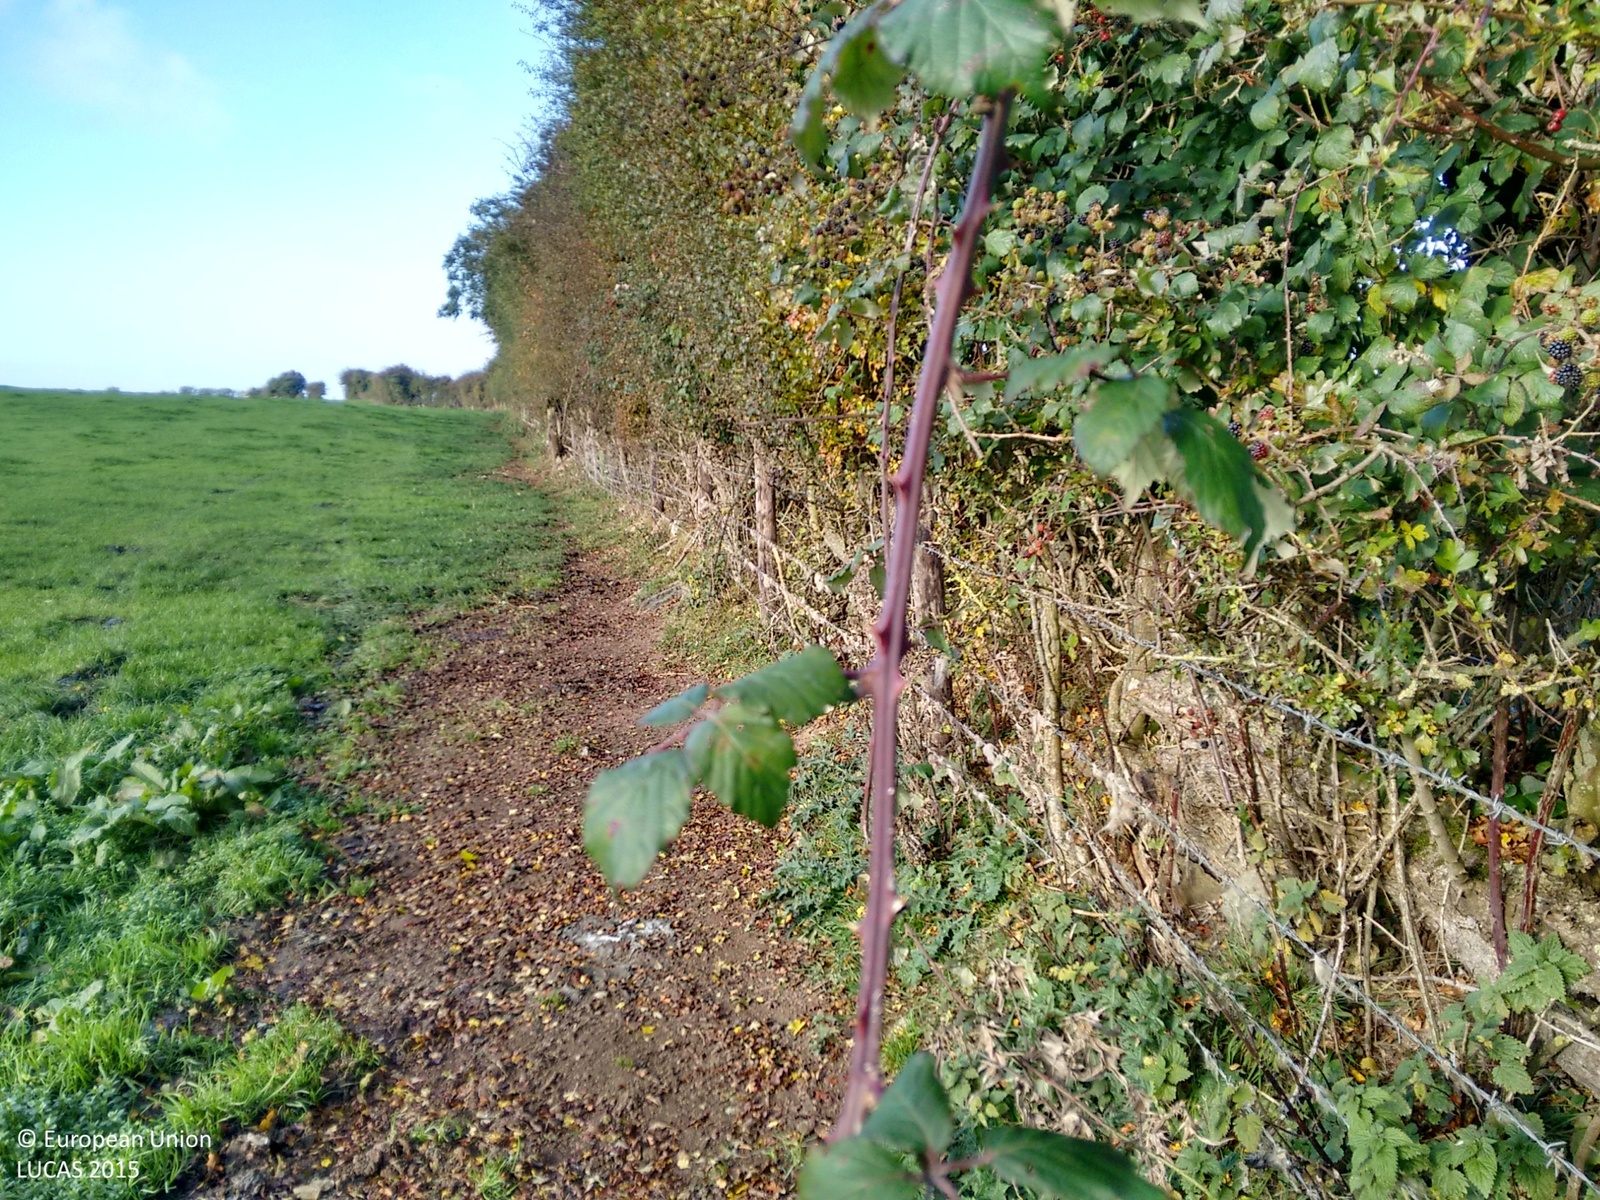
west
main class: Grassland
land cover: Grassland without tree/shrub cover
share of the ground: > 75 %
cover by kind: herbaceous plants 100 %
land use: Agriculture (excluding fallow land and kitchen gardens)
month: October
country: IE
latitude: 52.7951
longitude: -7.8638
